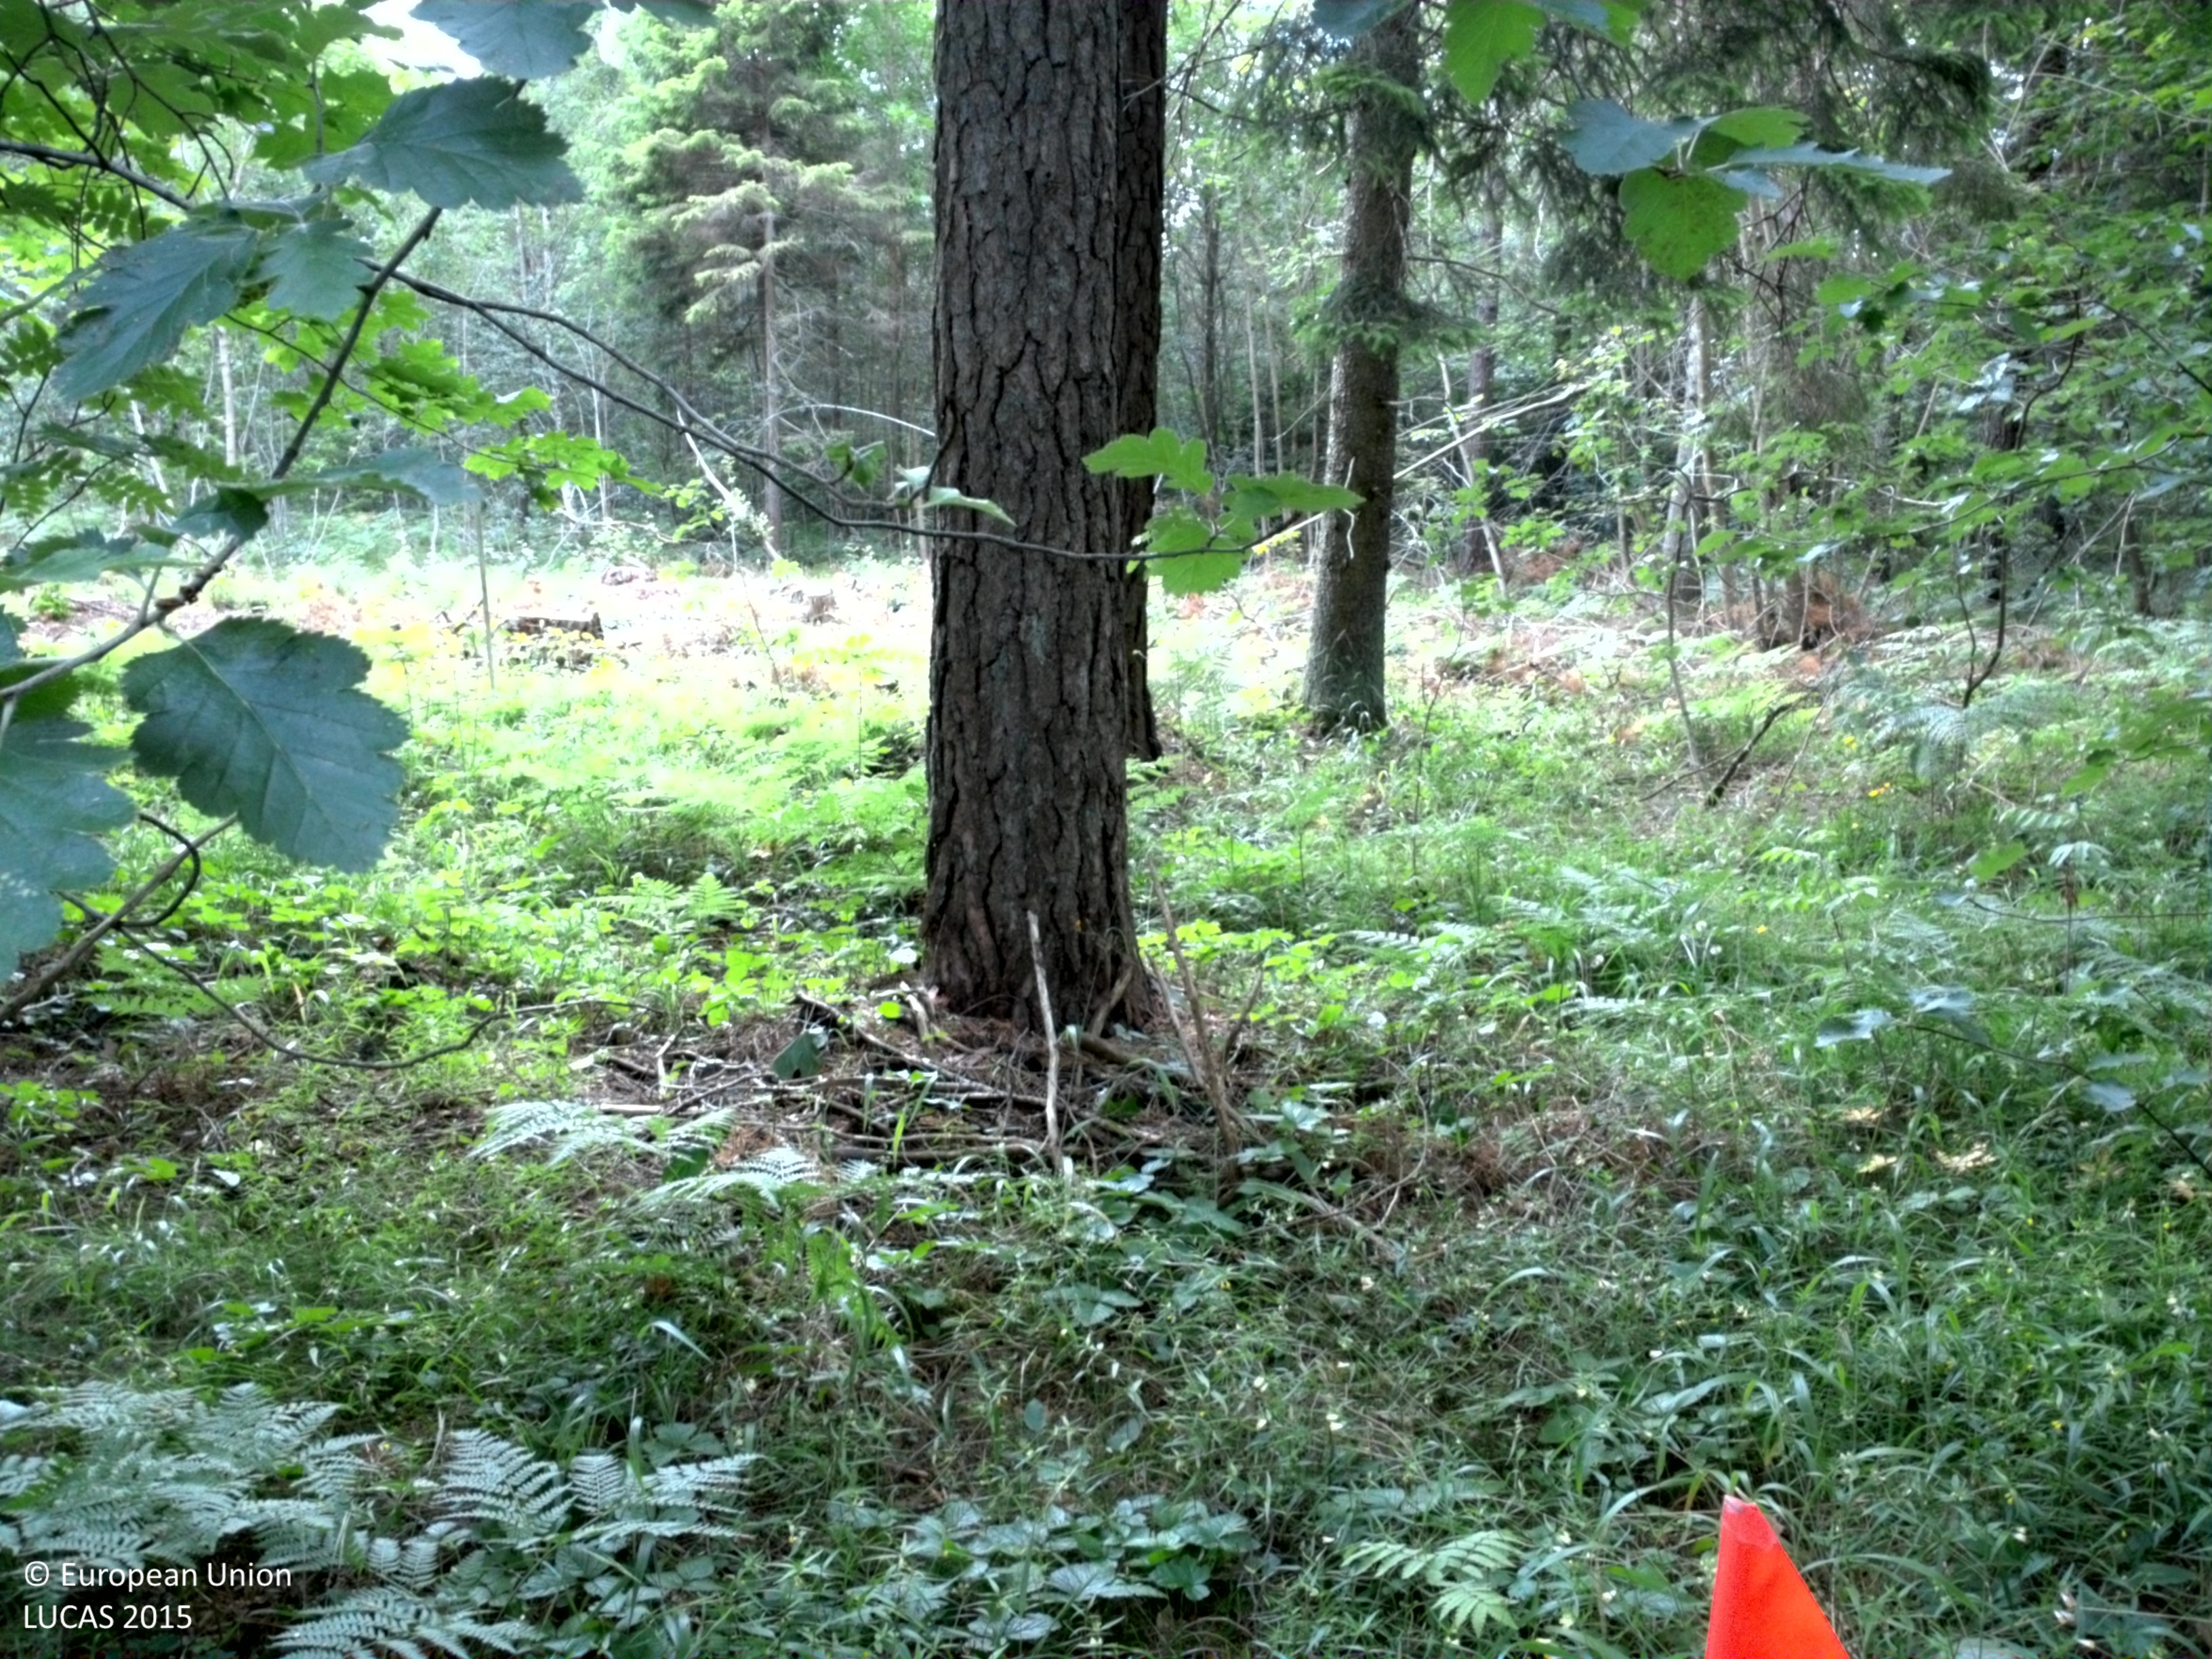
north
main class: Woodland
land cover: Spruce dominated coniferous woodland
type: hemiboreal forest and nemoral coniferous forest and mixed broadleaved-coniferous forest
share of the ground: 50 - 75 %
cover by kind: coniferous forest trees 60 %, herbaceous plants 25 %, shrubs 10 %, broadleaved forest trees 5 %
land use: Forestry
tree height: > 5 m
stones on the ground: < 10 %
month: July
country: SE
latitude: 57.4796
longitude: 18.4978
